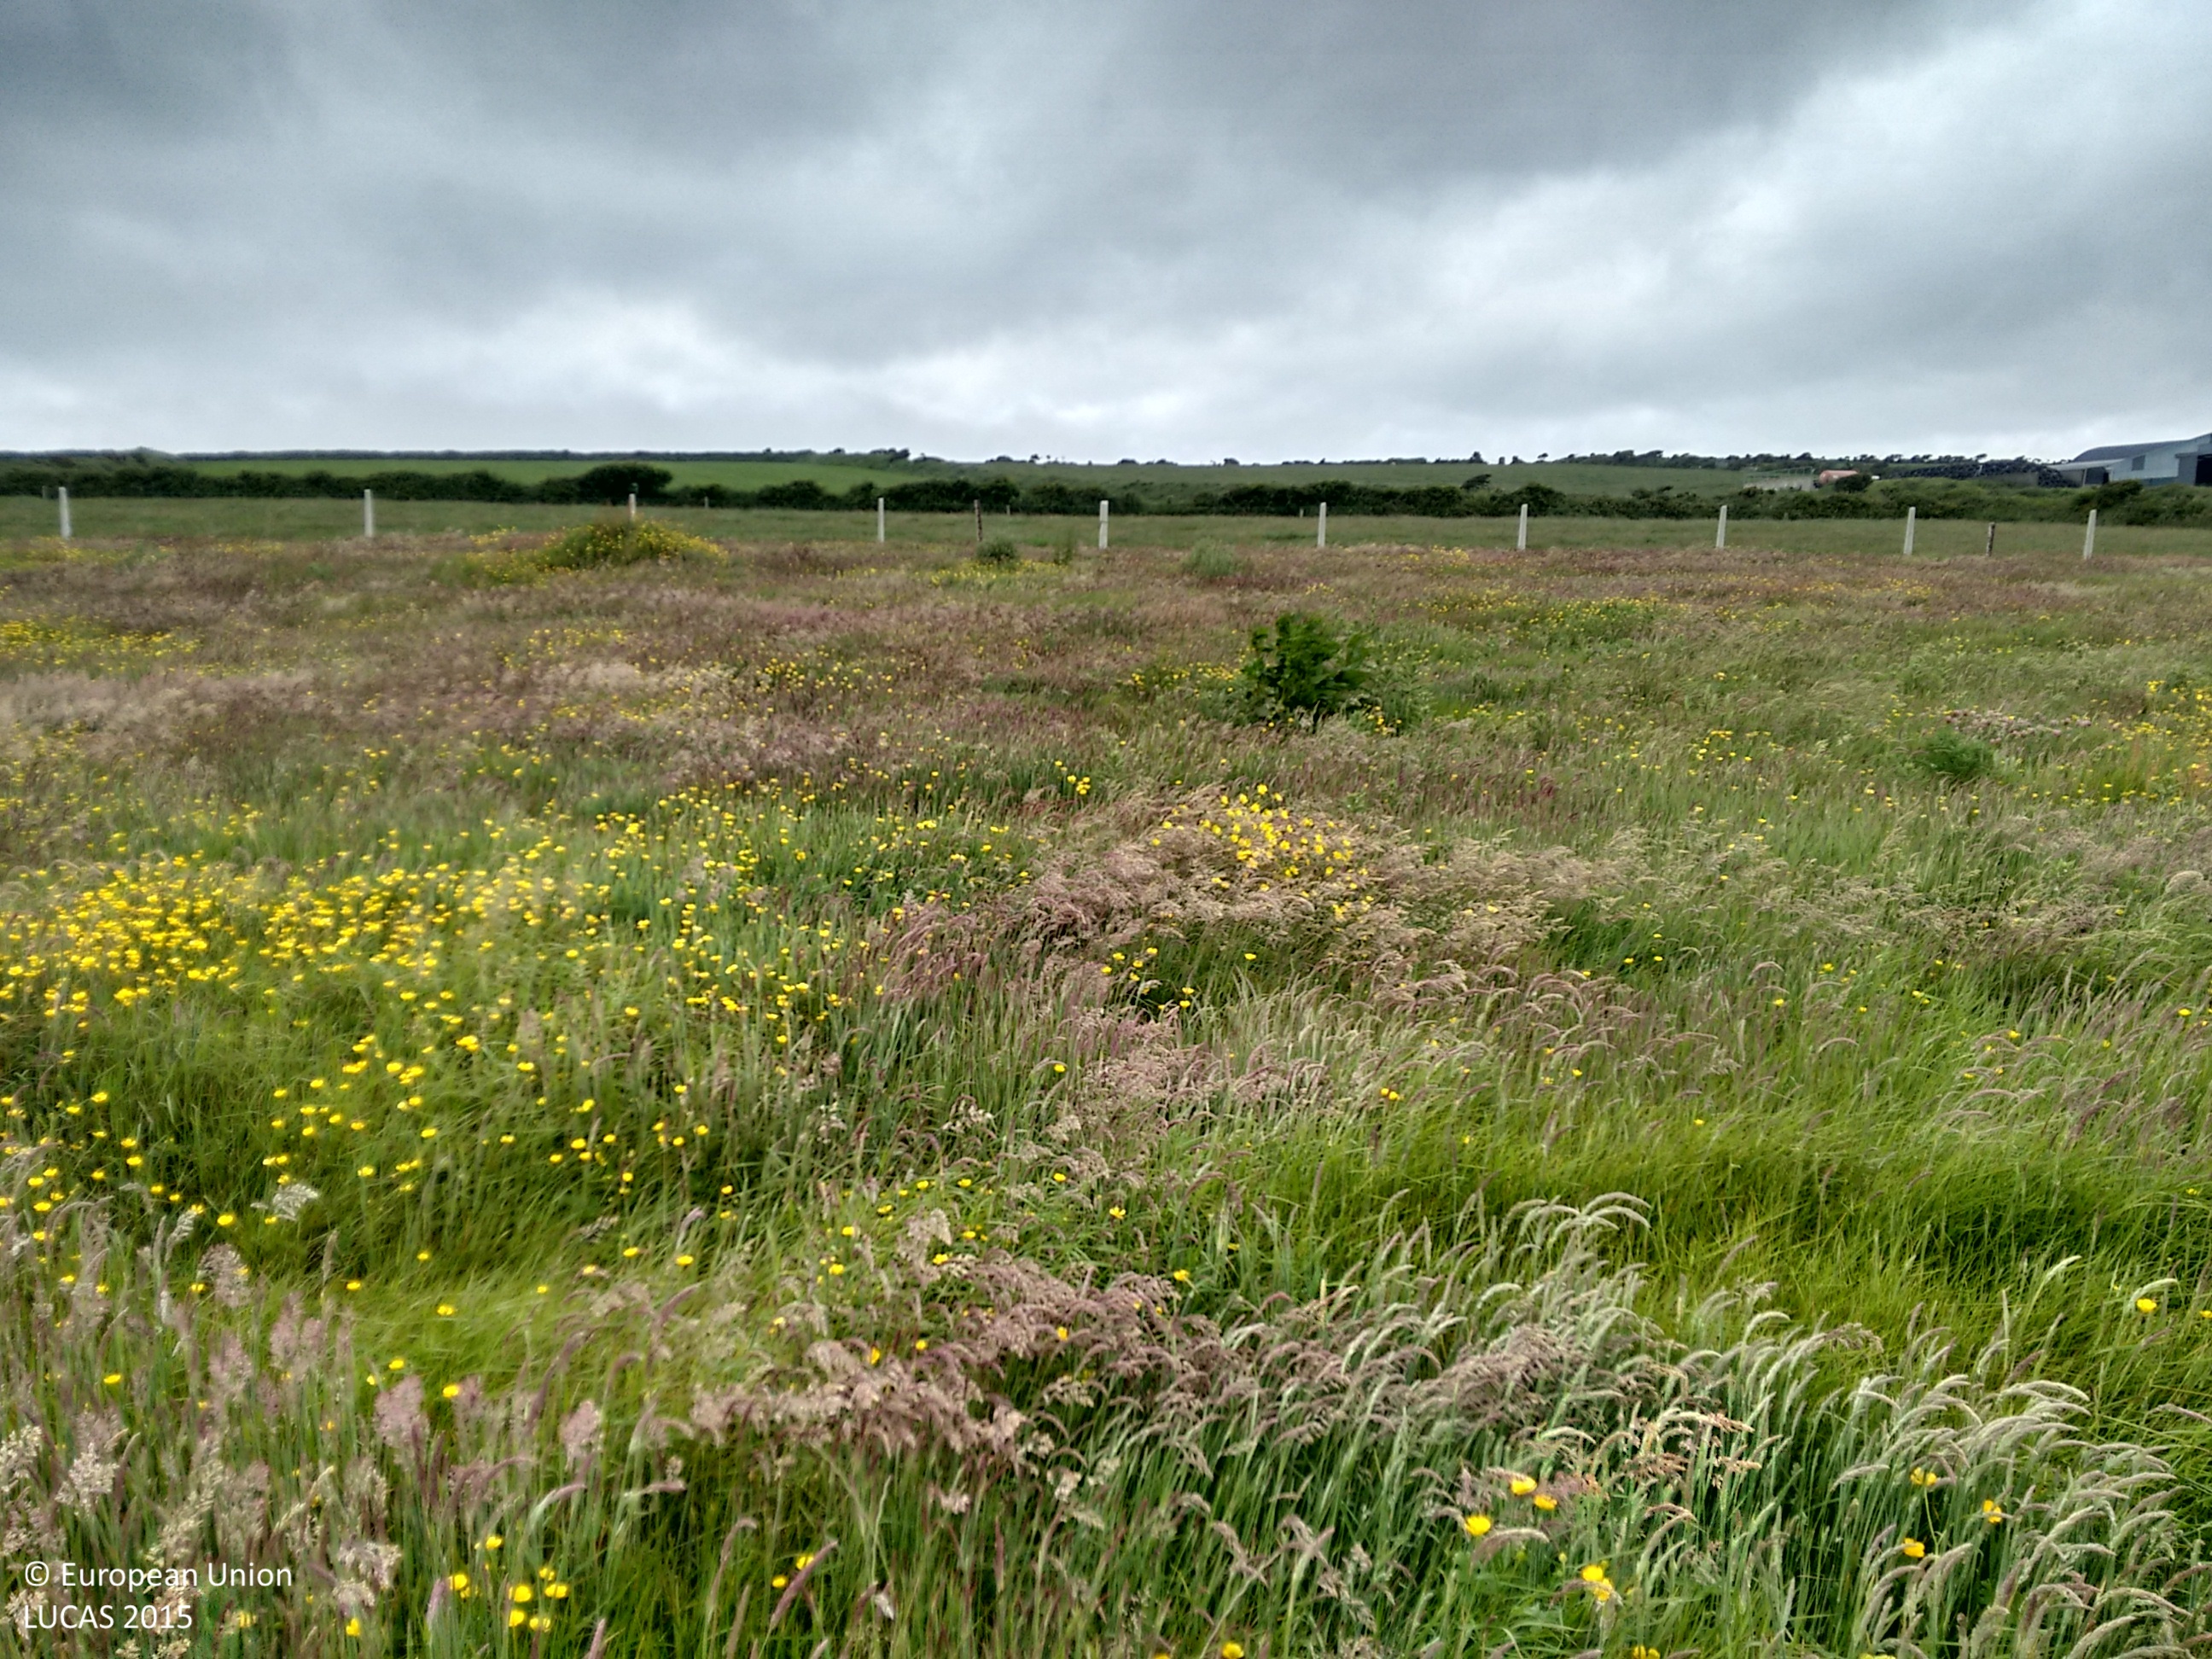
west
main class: Grassland
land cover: Grassland without tree/shrub cover
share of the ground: > 75 %
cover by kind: herbaceous plants 100 %
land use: Agriculture (excluding fallow land and kitchen gardens)
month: June
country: IE
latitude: 52.1388
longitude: -7.2006
